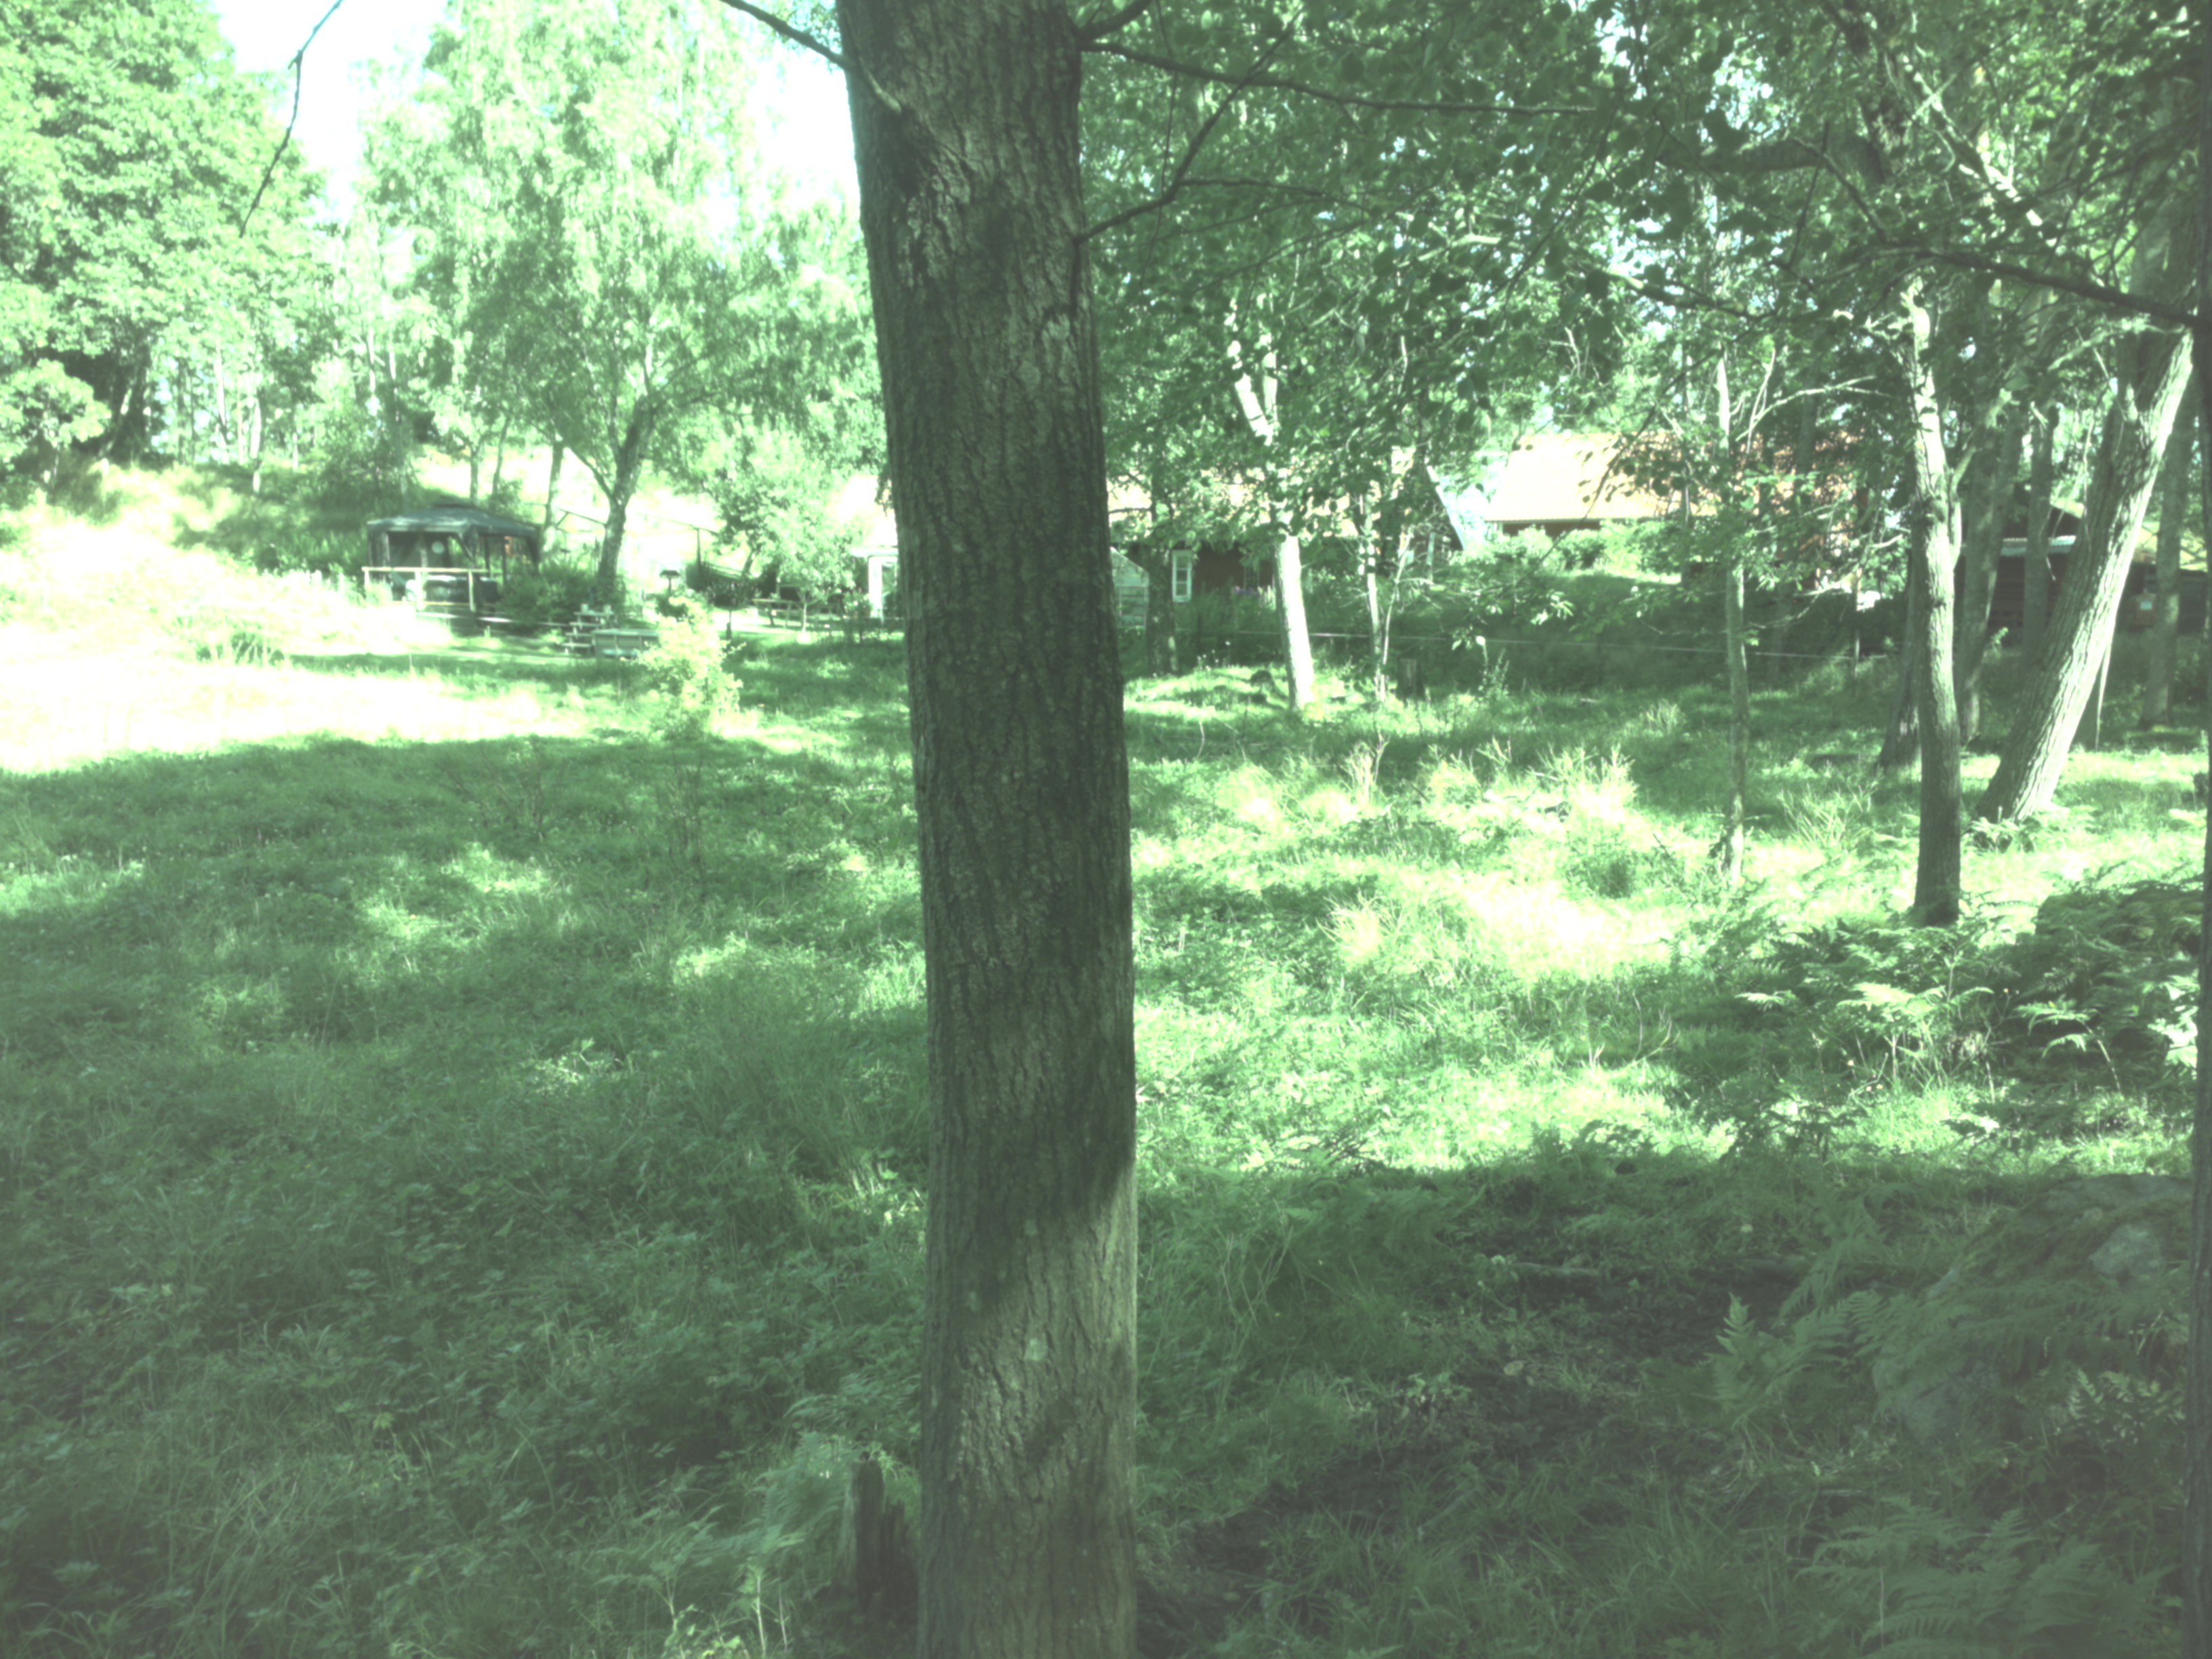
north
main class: Woodland
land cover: Broadleaved woodland
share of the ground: 50 - 75 %
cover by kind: herbaceous plants 50 %, broadleaved forest trees 40 %, coniferous forest trees 10 %
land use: Agriculture (excluding fallow land and kitchen gardens)
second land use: Forestry
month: August
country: SE
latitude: 59.1714
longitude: 17.7479
